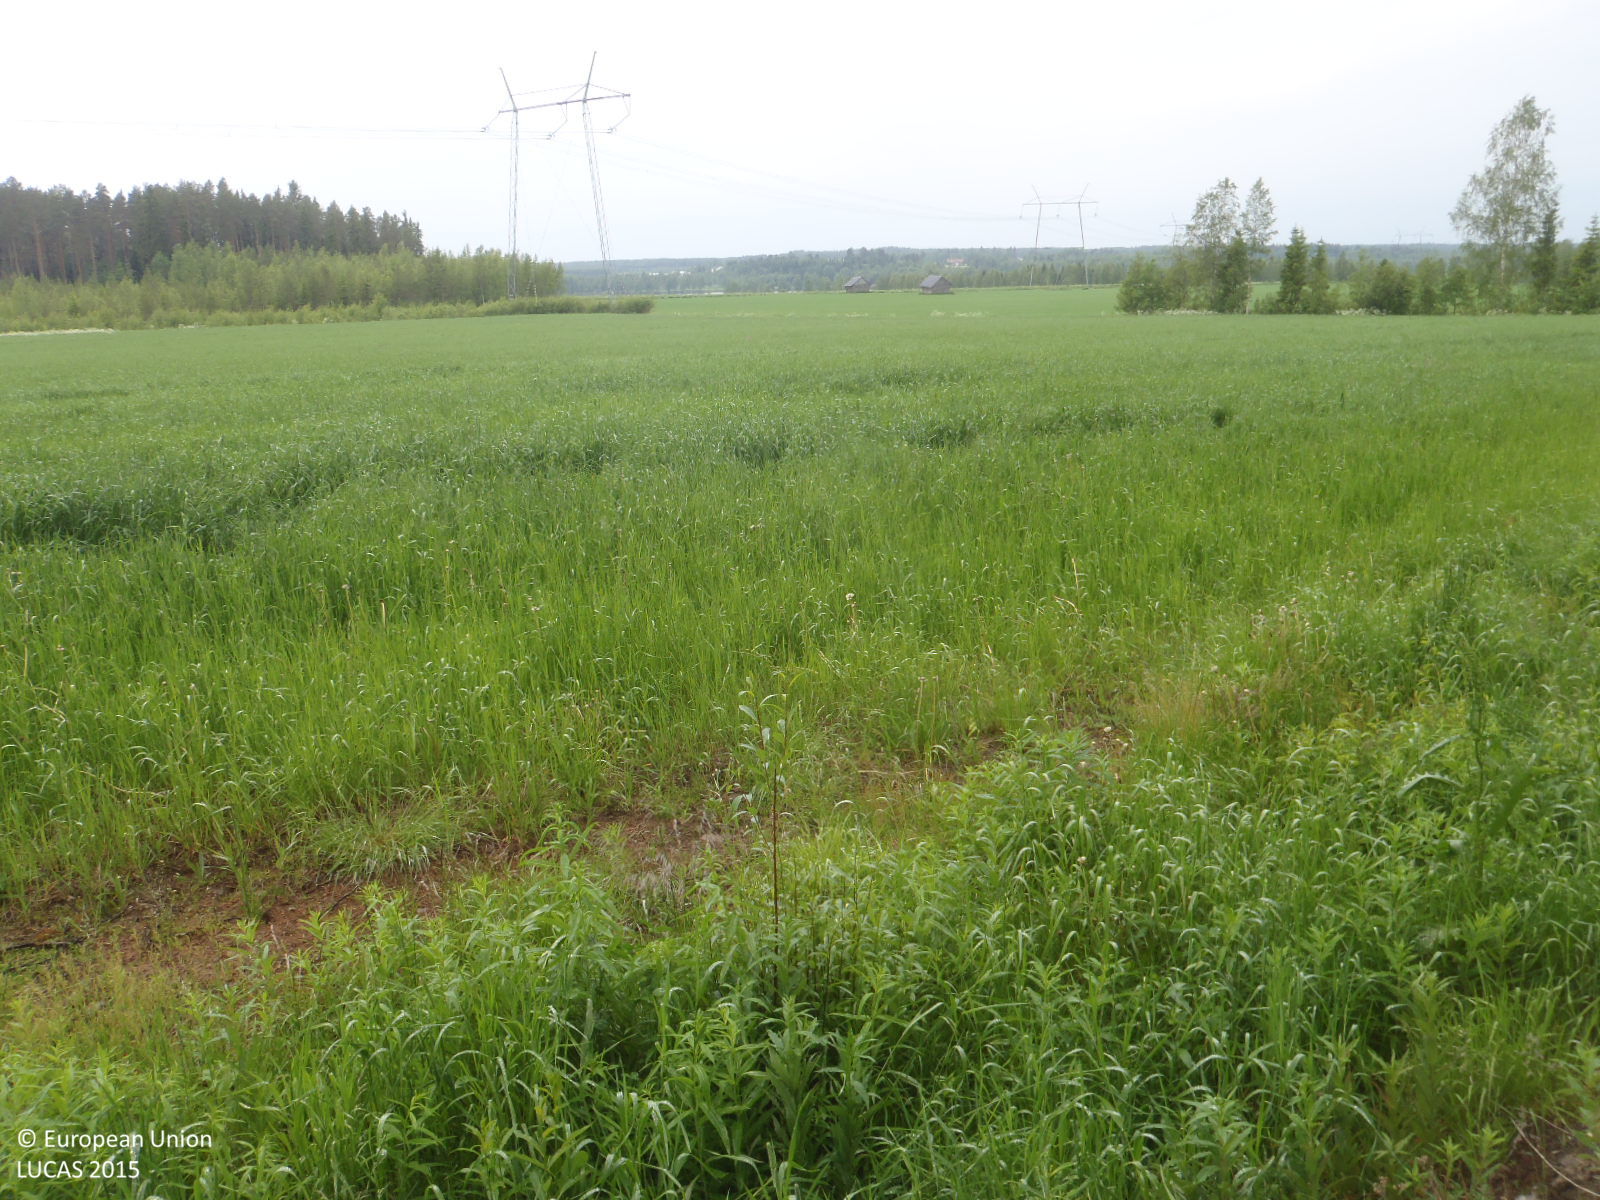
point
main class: Cropland
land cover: Temporary grasslands
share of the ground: > 75 %
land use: Agriculture (excluding fallow land and kitchen gardens)
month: June
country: FI
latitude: 64.9095
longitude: 25.8385
